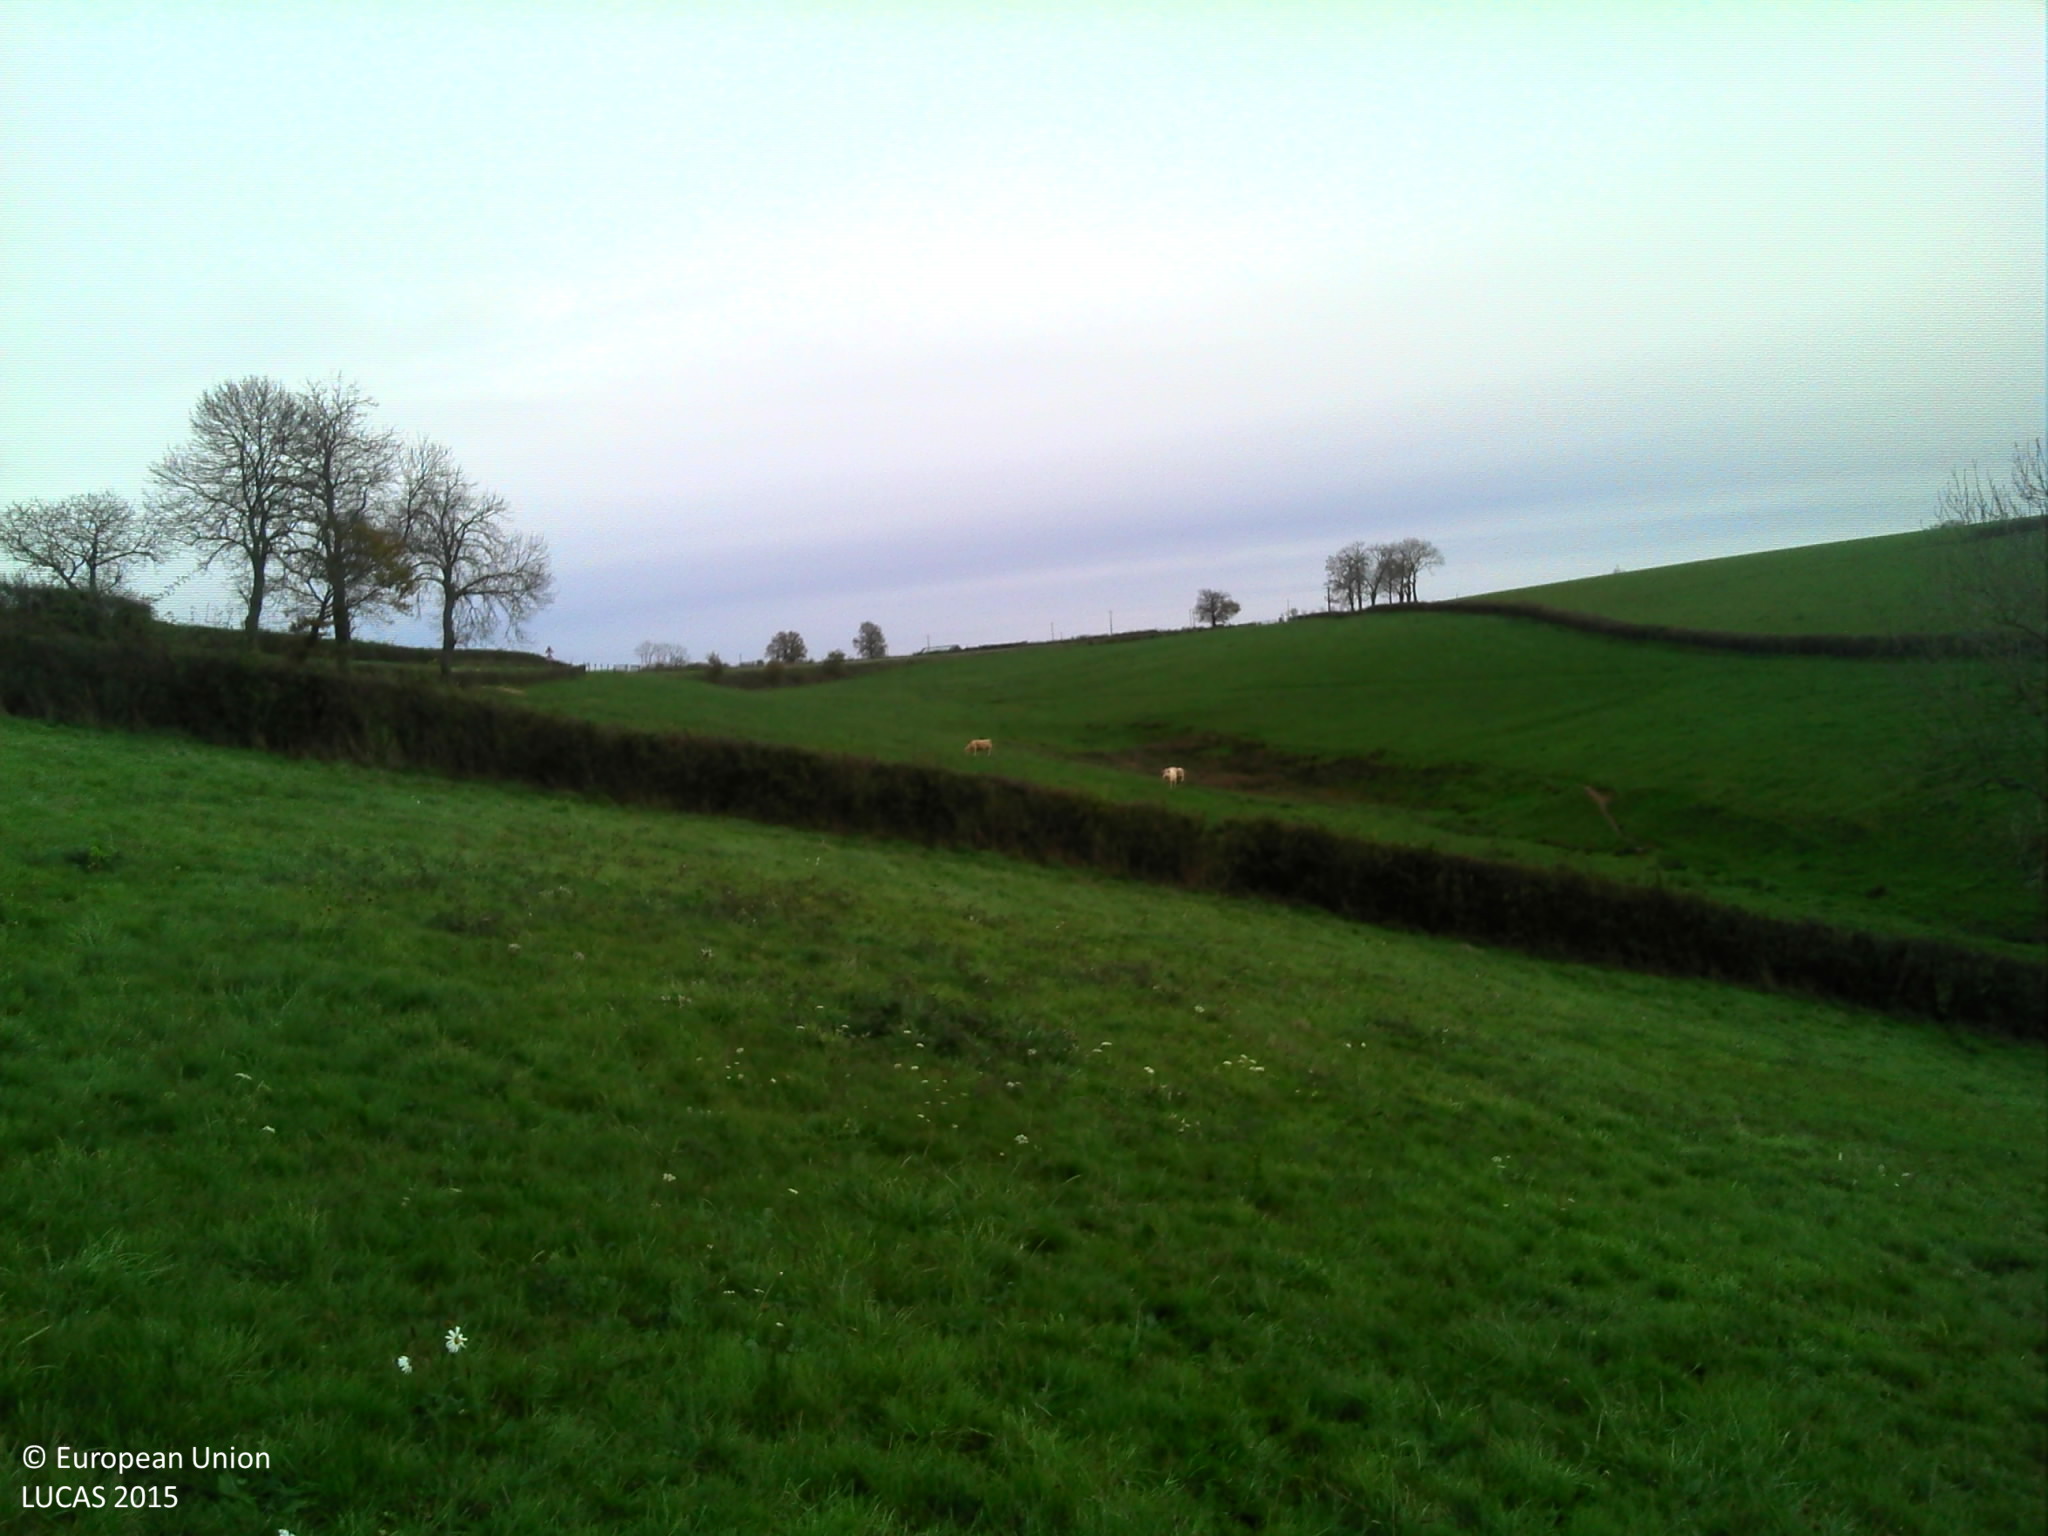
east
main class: Grassland
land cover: Grassland without tree/shrub cover
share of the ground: > 75 %
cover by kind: herbaceous plants 100 %
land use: Agriculture (excluding fallow land and kitchen gardens)
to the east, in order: Grassland without tree/shrub cover; Fences; Managed hedges; Fences; Grassland without tree/shrub cover
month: November
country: FR
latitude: 46.3639
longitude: 3.6958
